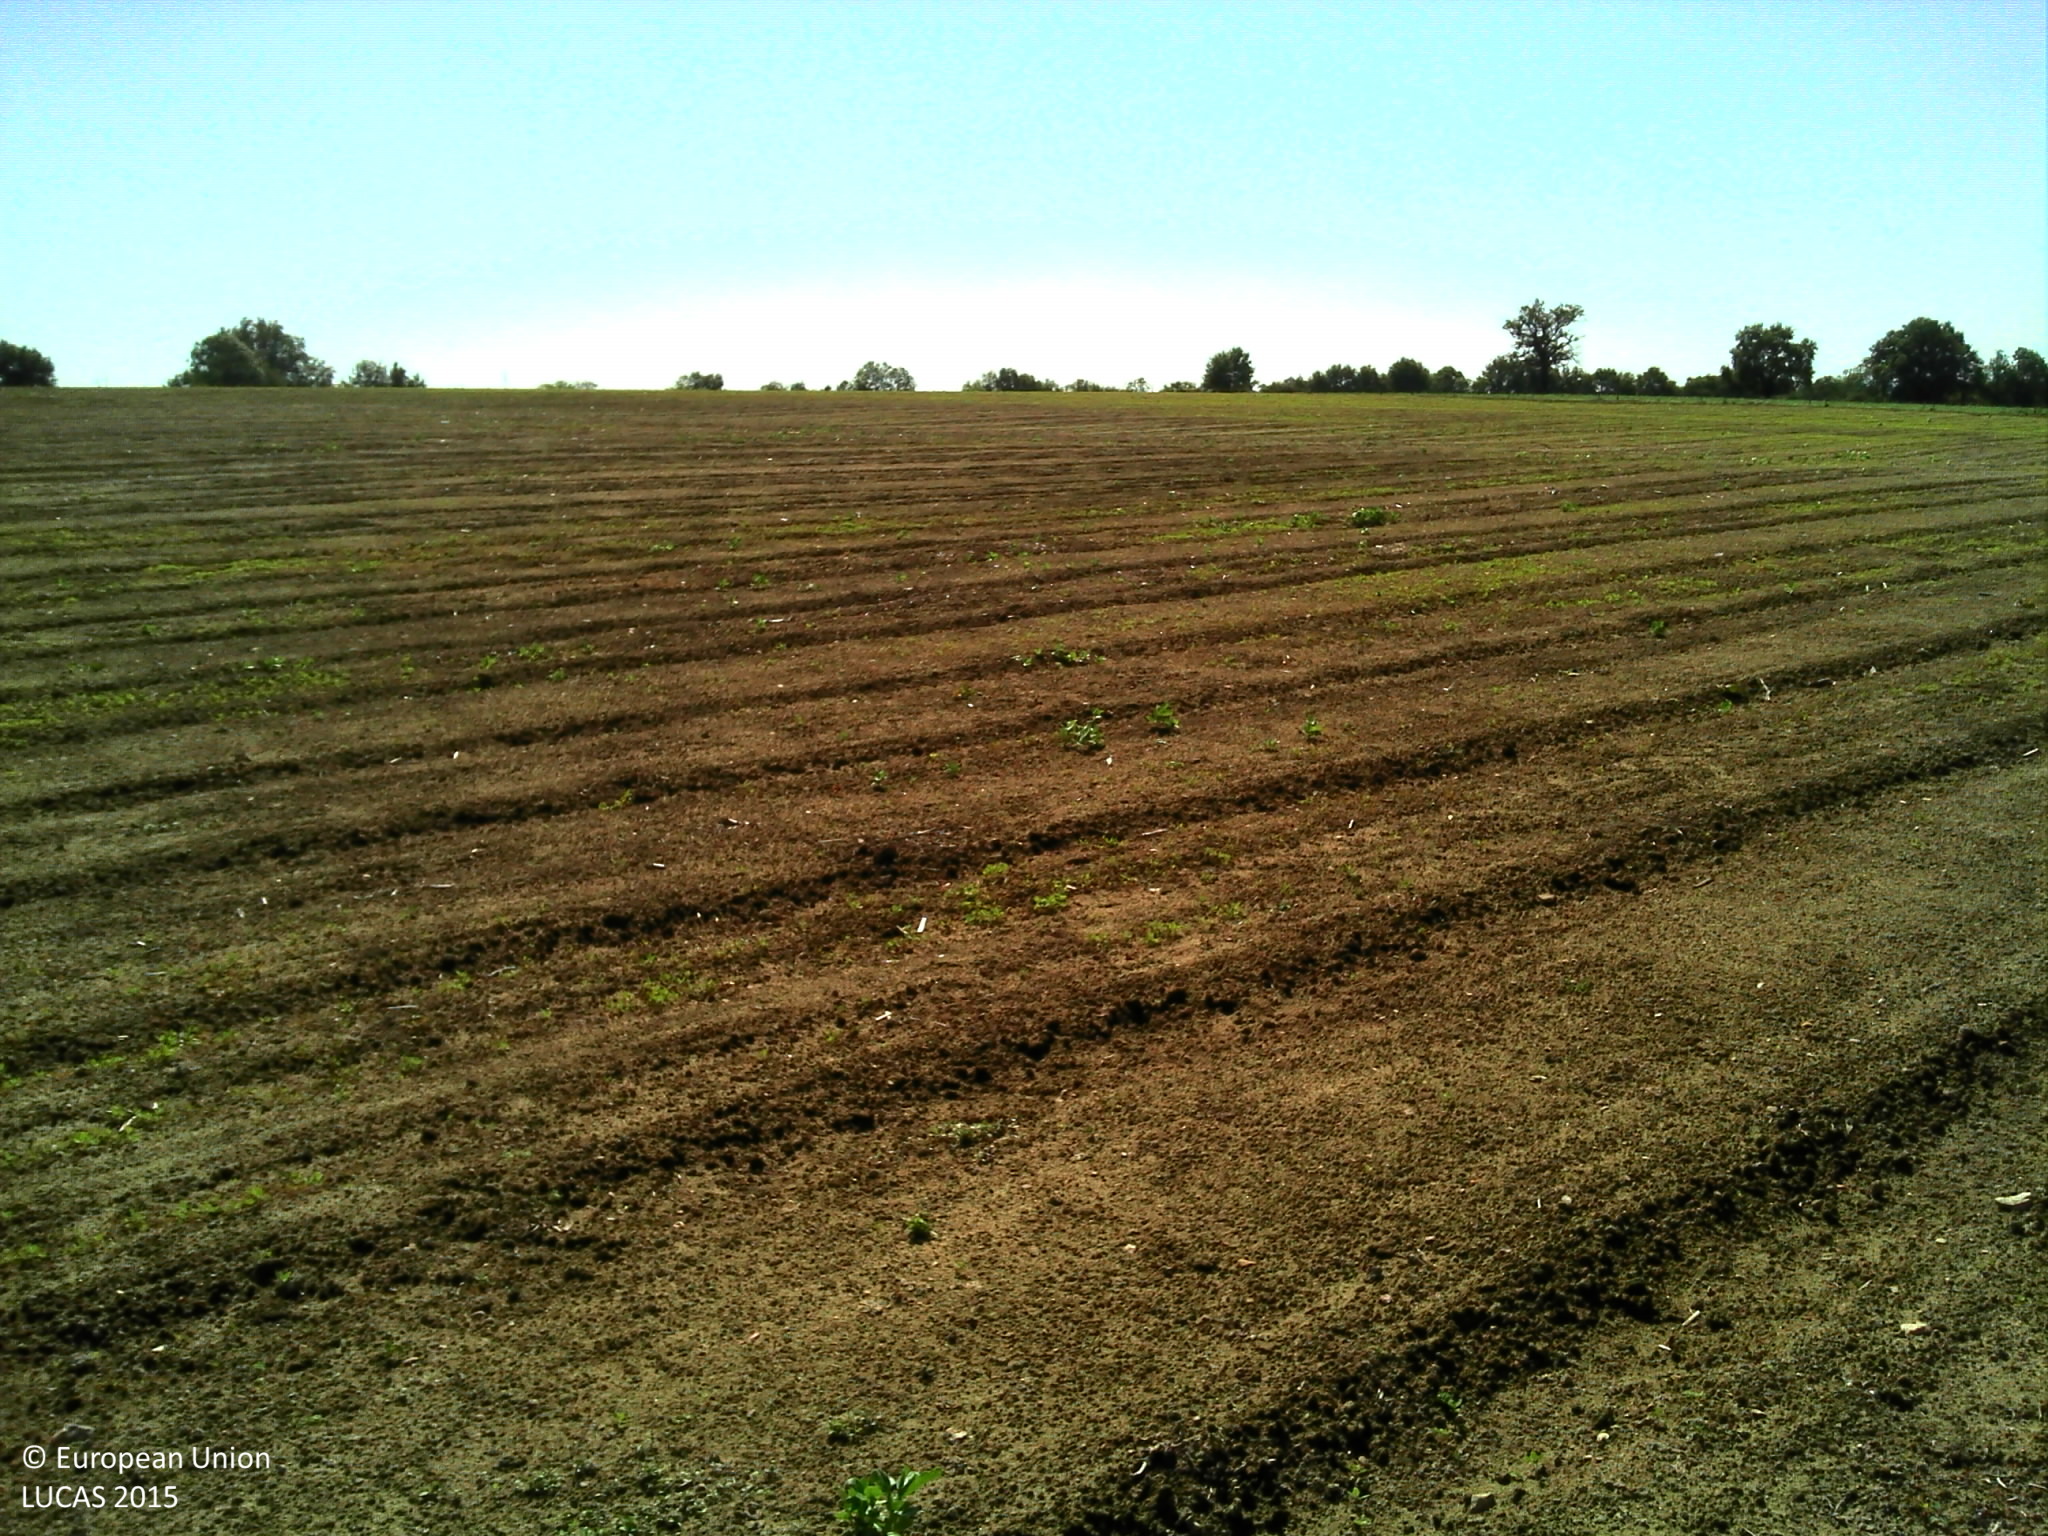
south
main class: Cropland
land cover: Dry pulses
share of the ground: > 75 %
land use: Agriculture (excluding fallow land and kitchen gardens)
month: September
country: FR
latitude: 46.5990
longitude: -1.3543
